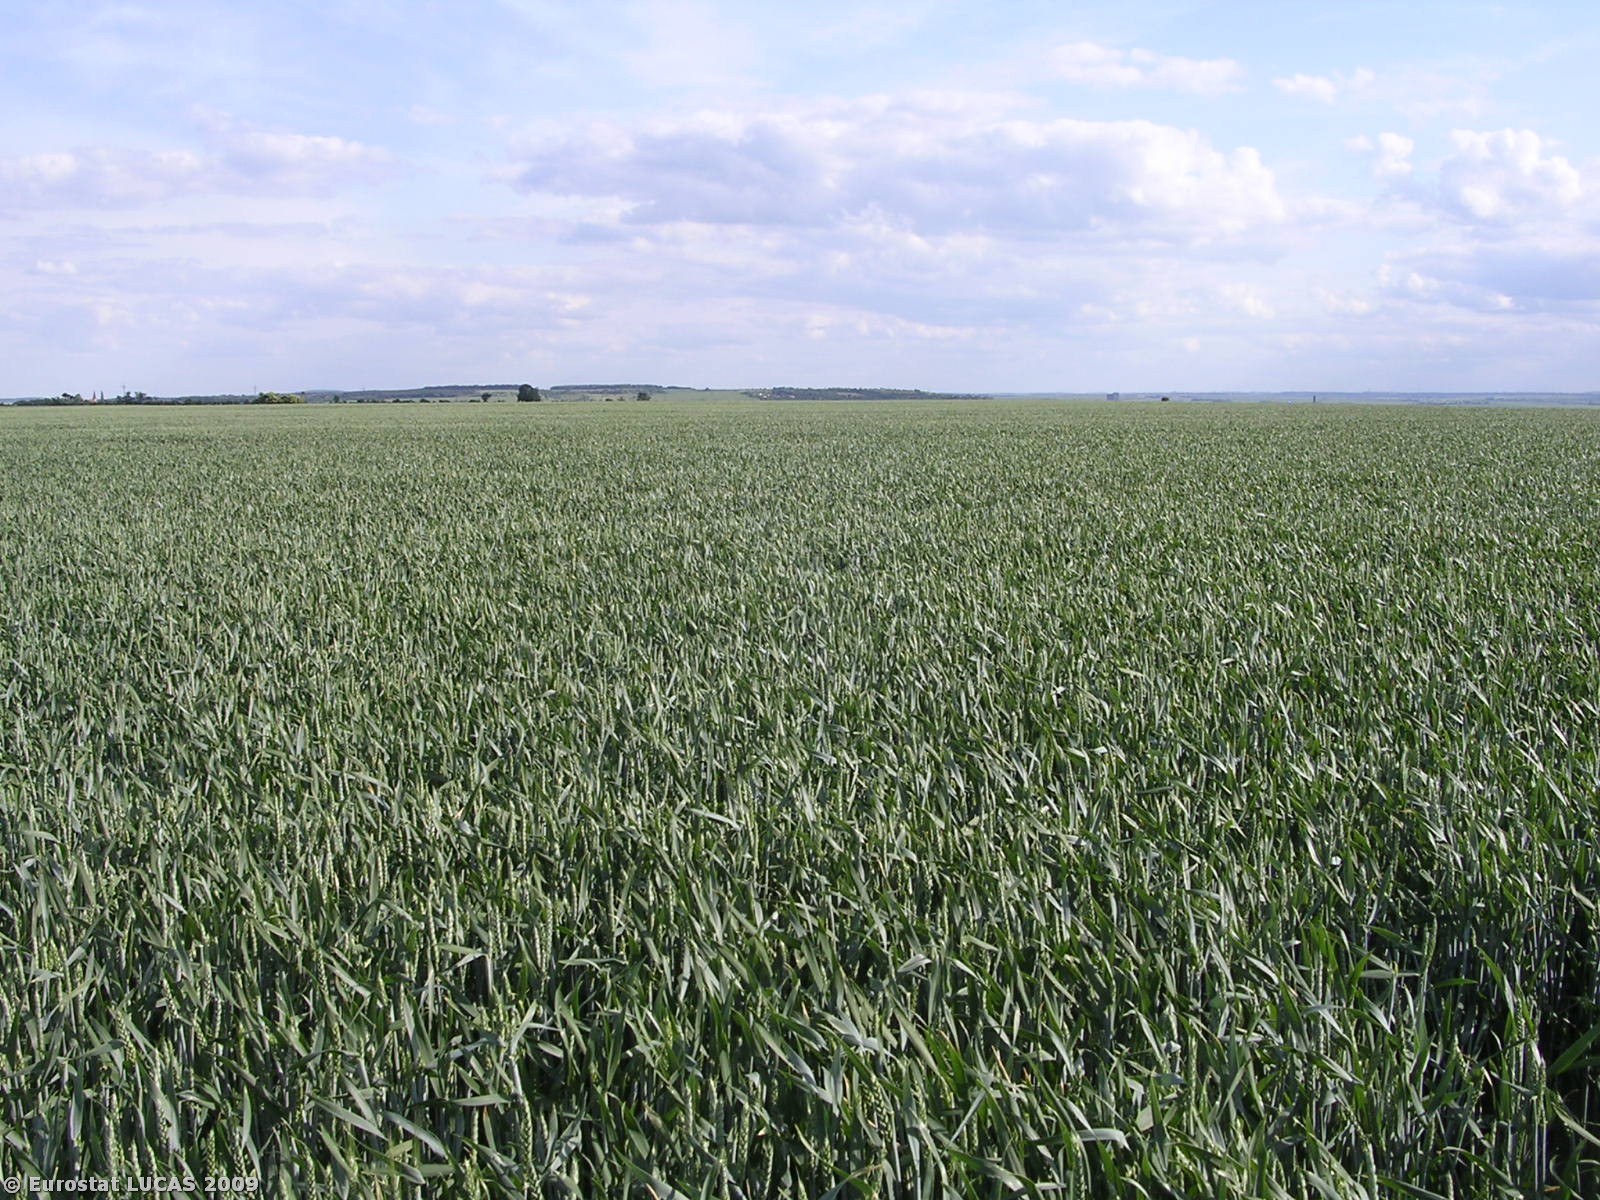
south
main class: Cropland
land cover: Common wheat
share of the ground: > 75 %
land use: Agriculture (excluding fallow land and kitchen gardens)
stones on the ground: < 10 %
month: May
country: CZ
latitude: 50.3209
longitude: 14.2570
